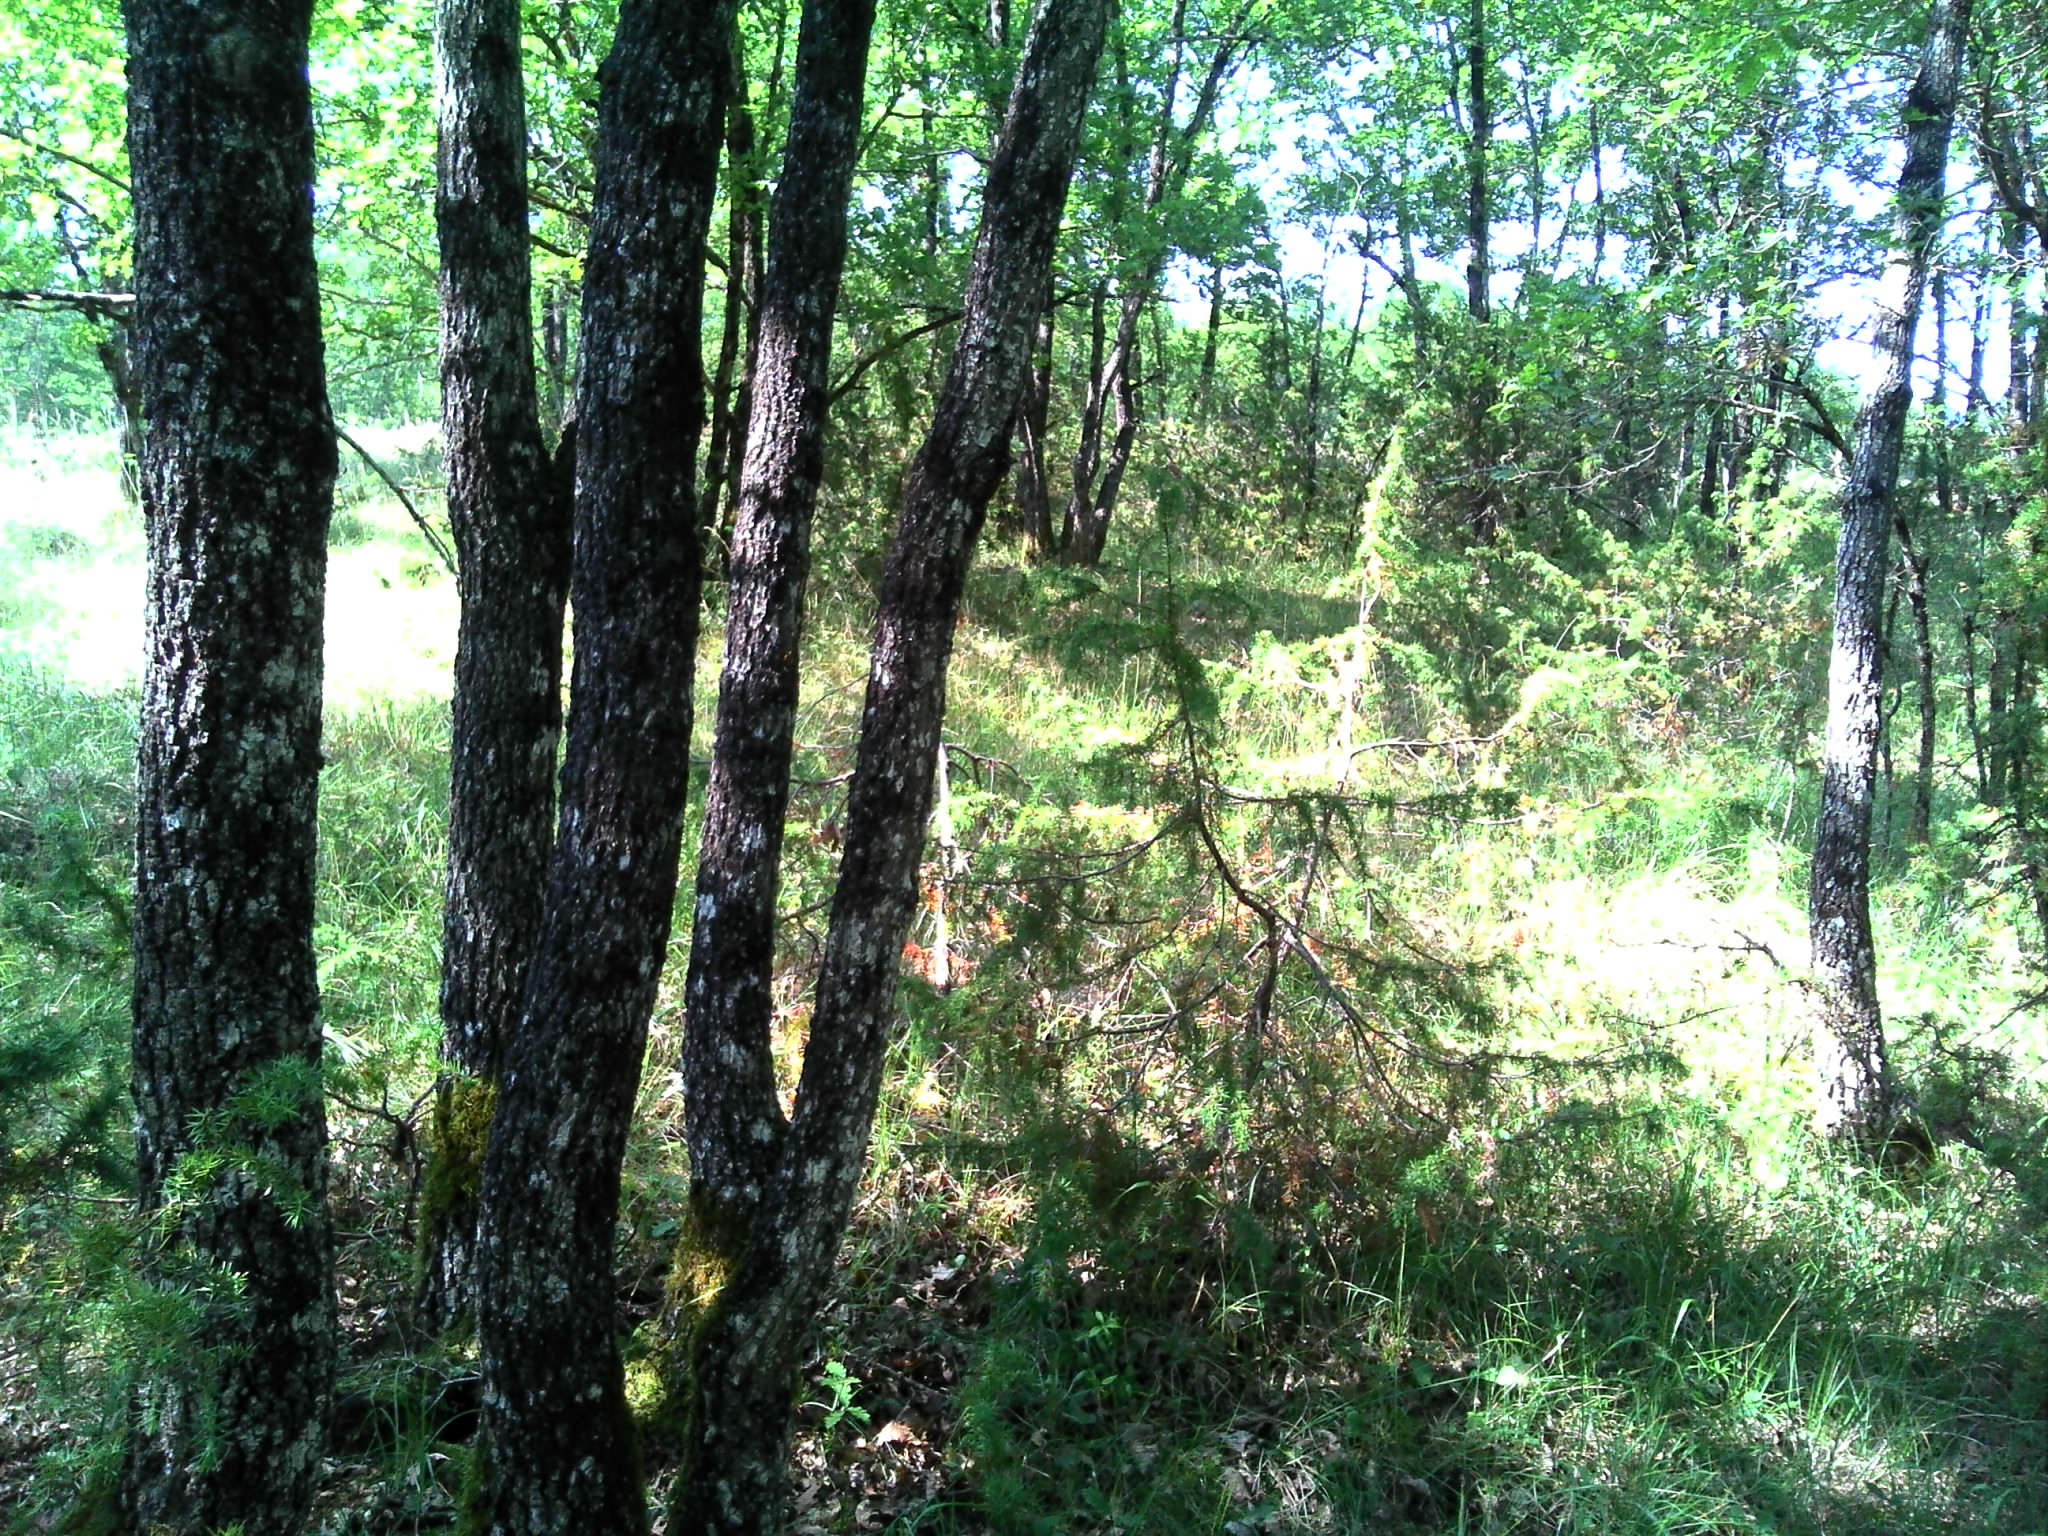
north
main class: Woodland
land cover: Broadleaved woodland
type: thermophilous deciduous forest
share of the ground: > 75 %
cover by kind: broadleaved forest trees 95 %, herbaceous plants 5 %
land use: Forestry
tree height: > 5 m
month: June
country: FR
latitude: 44.9748
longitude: 1.4364
